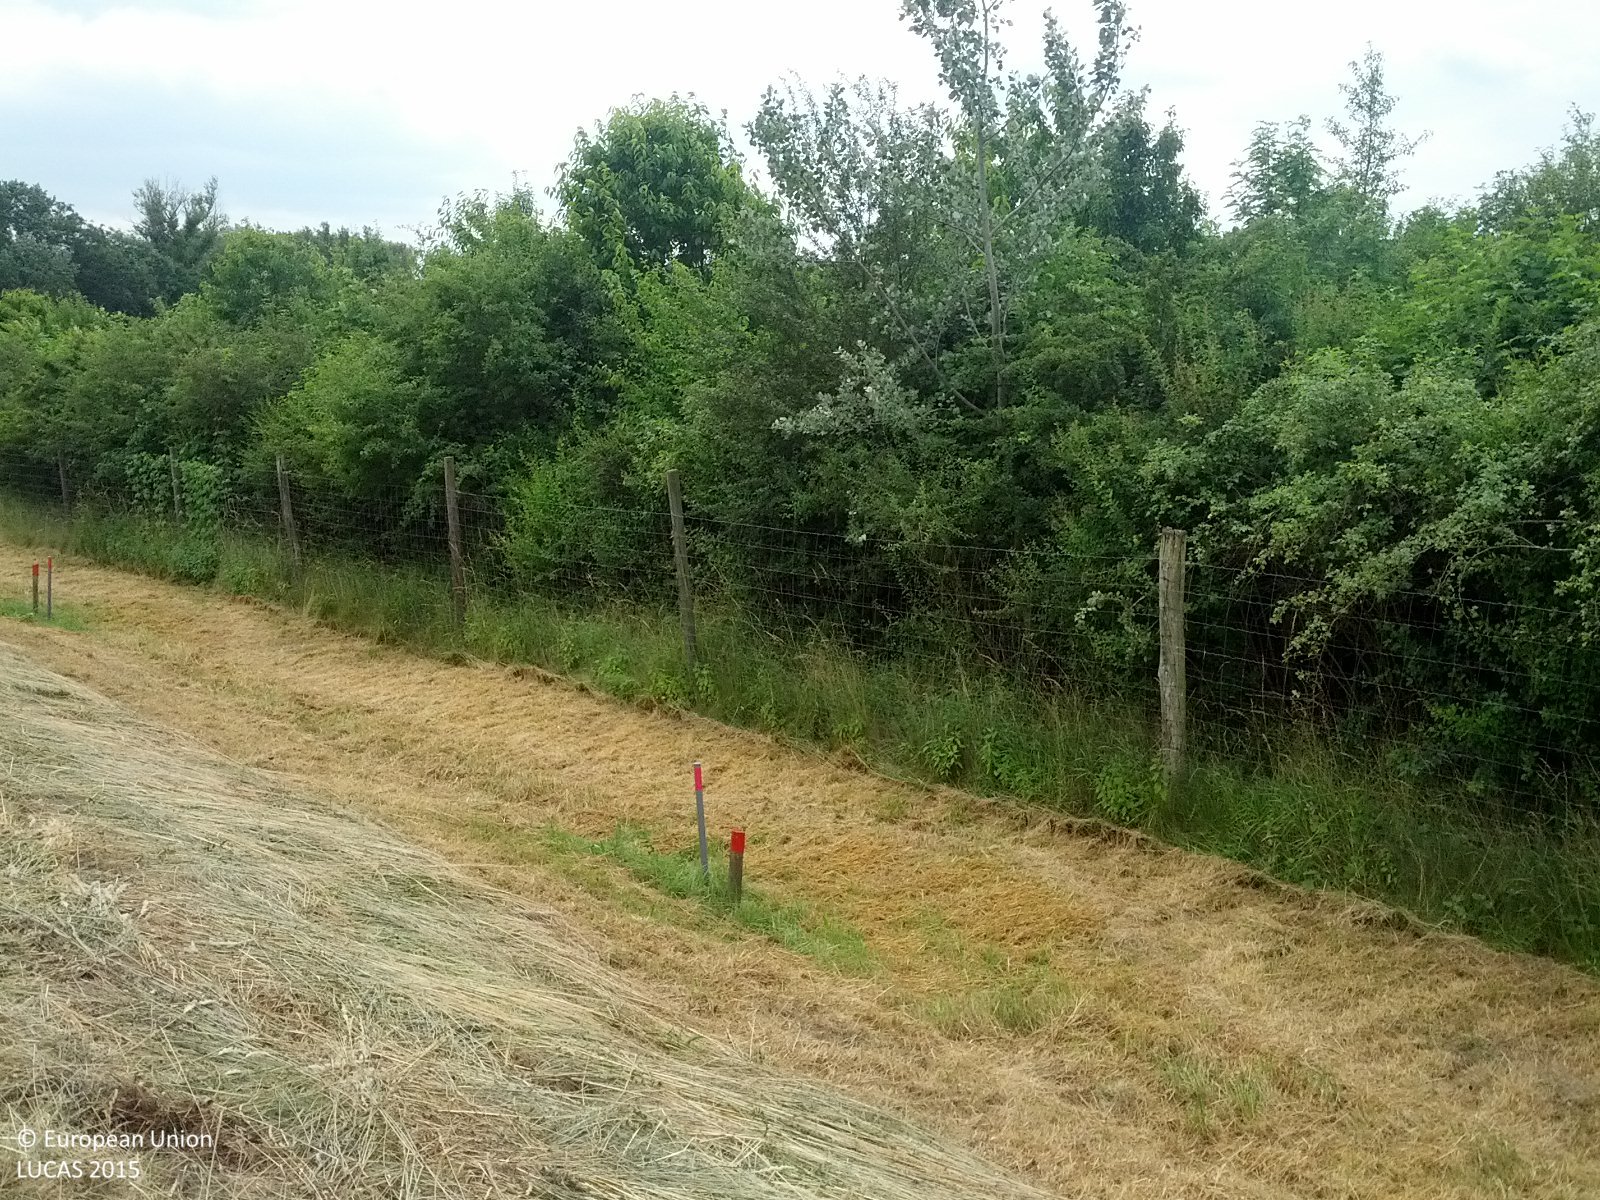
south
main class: Grassland
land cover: Grassland without tree/shrub cover
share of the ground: > 75 %
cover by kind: herbaceous plants 100 %
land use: Protection infrastructures
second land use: Agriculture (excluding fallow land and kitchen gardens)
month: June
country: AT
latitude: 48.1534
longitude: 16.5790
